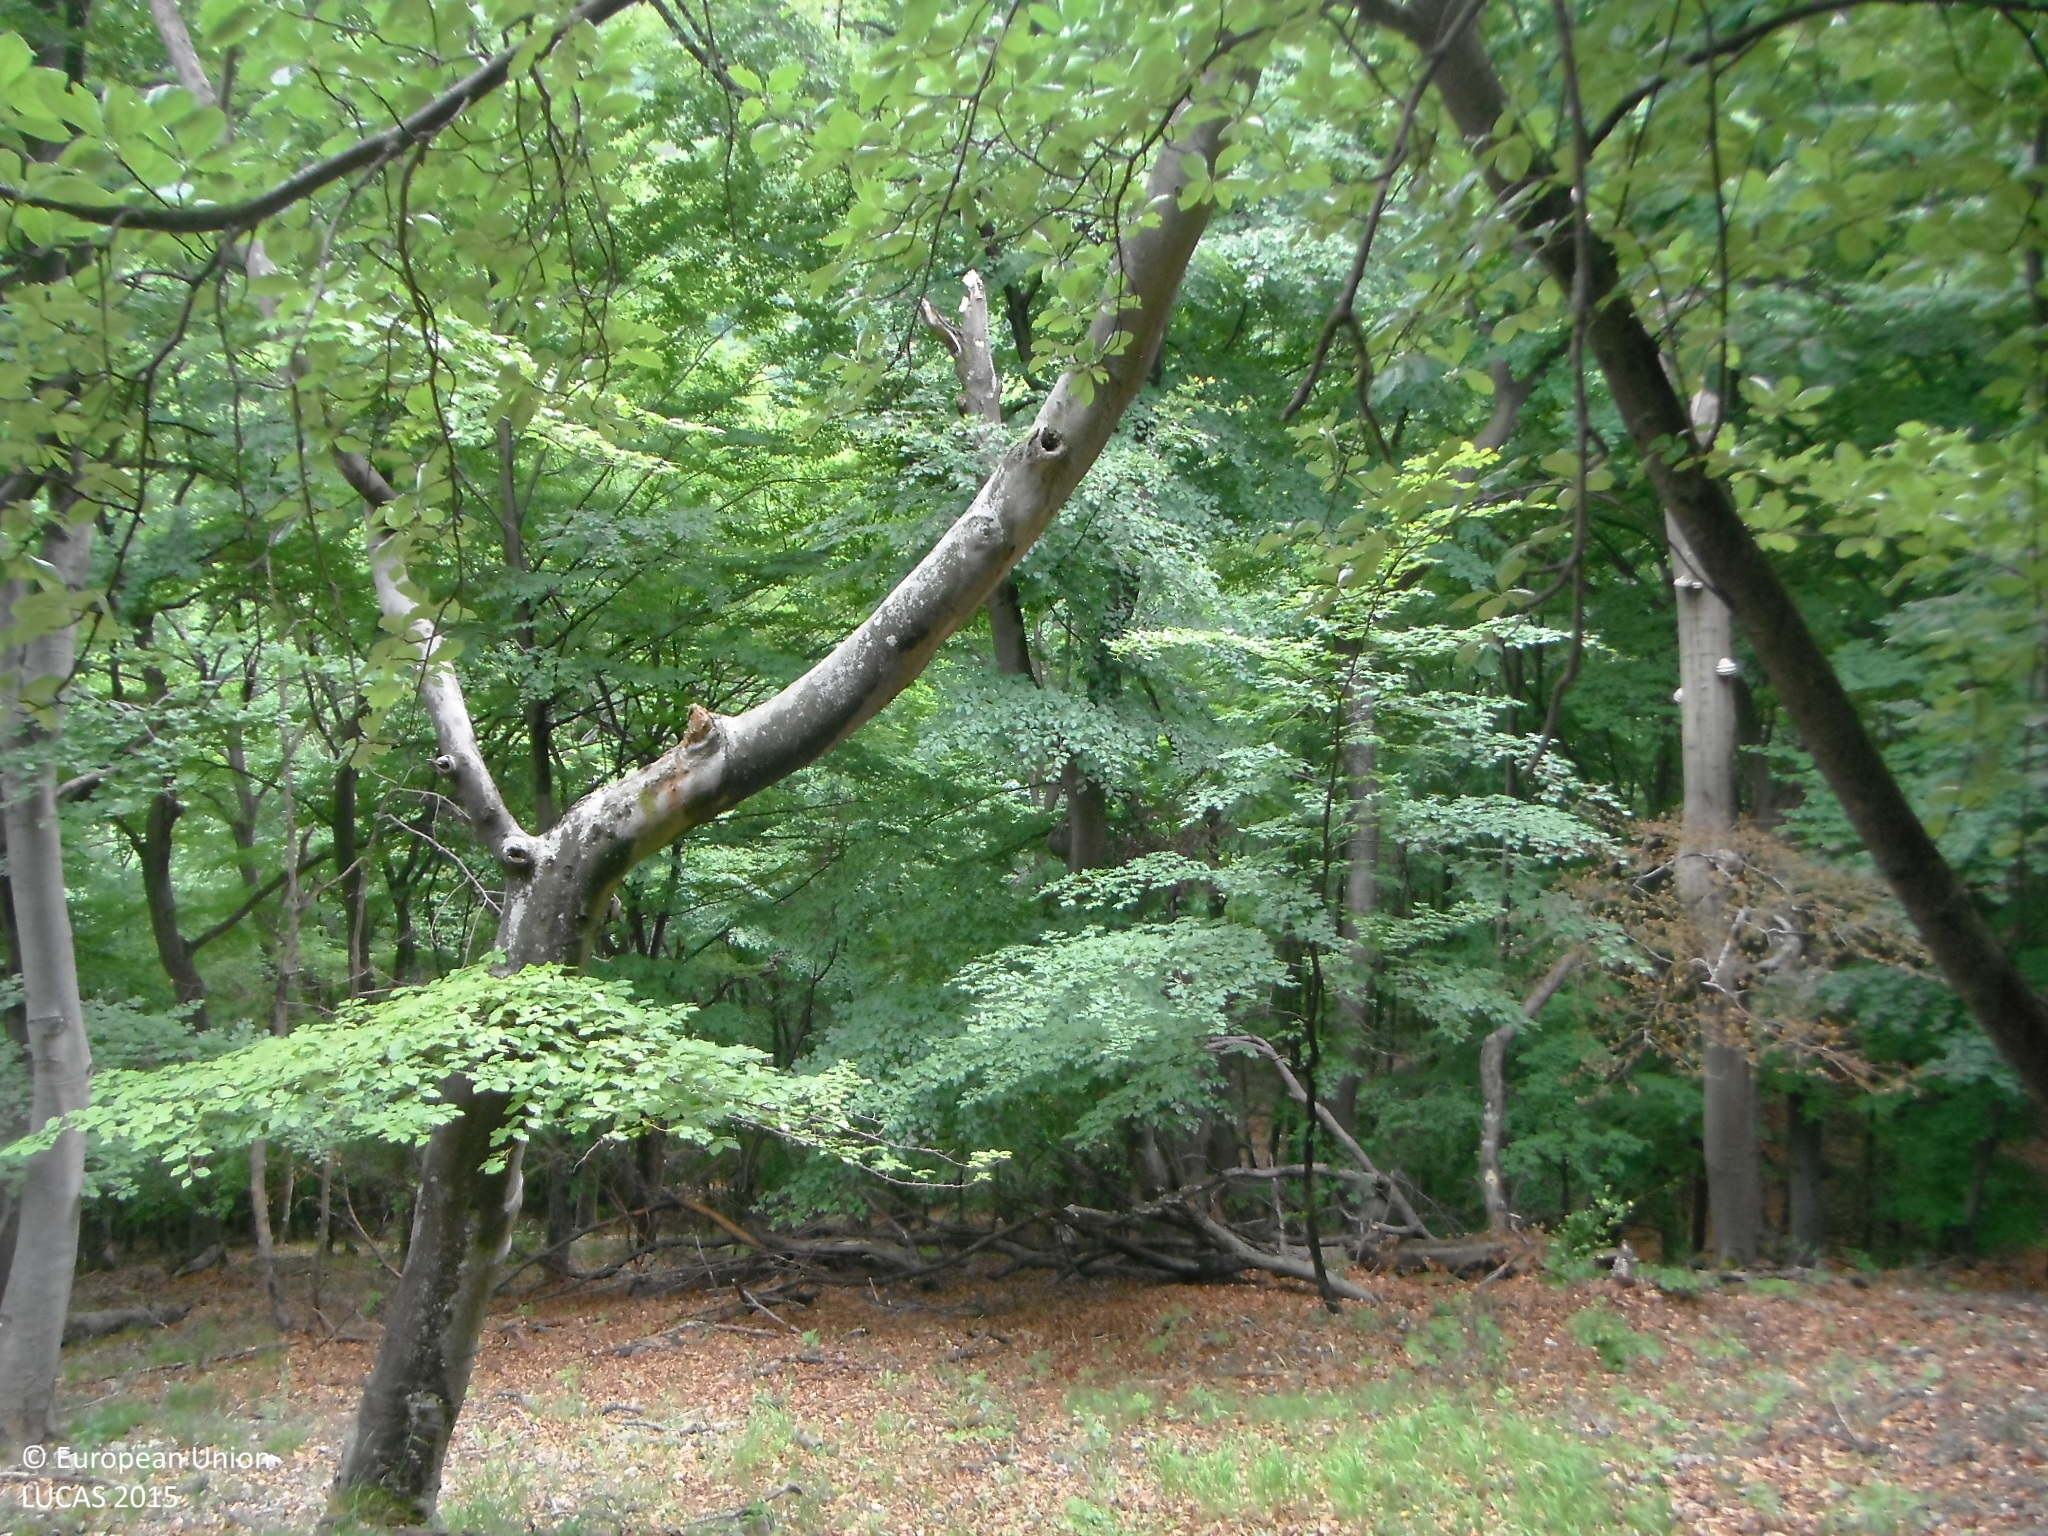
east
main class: Woodland
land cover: Broadleaved woodland
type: beech forest
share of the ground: > 75 %
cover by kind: broadleaved forest trees 80 %, herbaceous plants 15 %, shrubs 5 %
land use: Forestry
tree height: > 5 m
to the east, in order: Broadleaved woodland
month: June
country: SK
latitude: 48.7541
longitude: 18.3817
